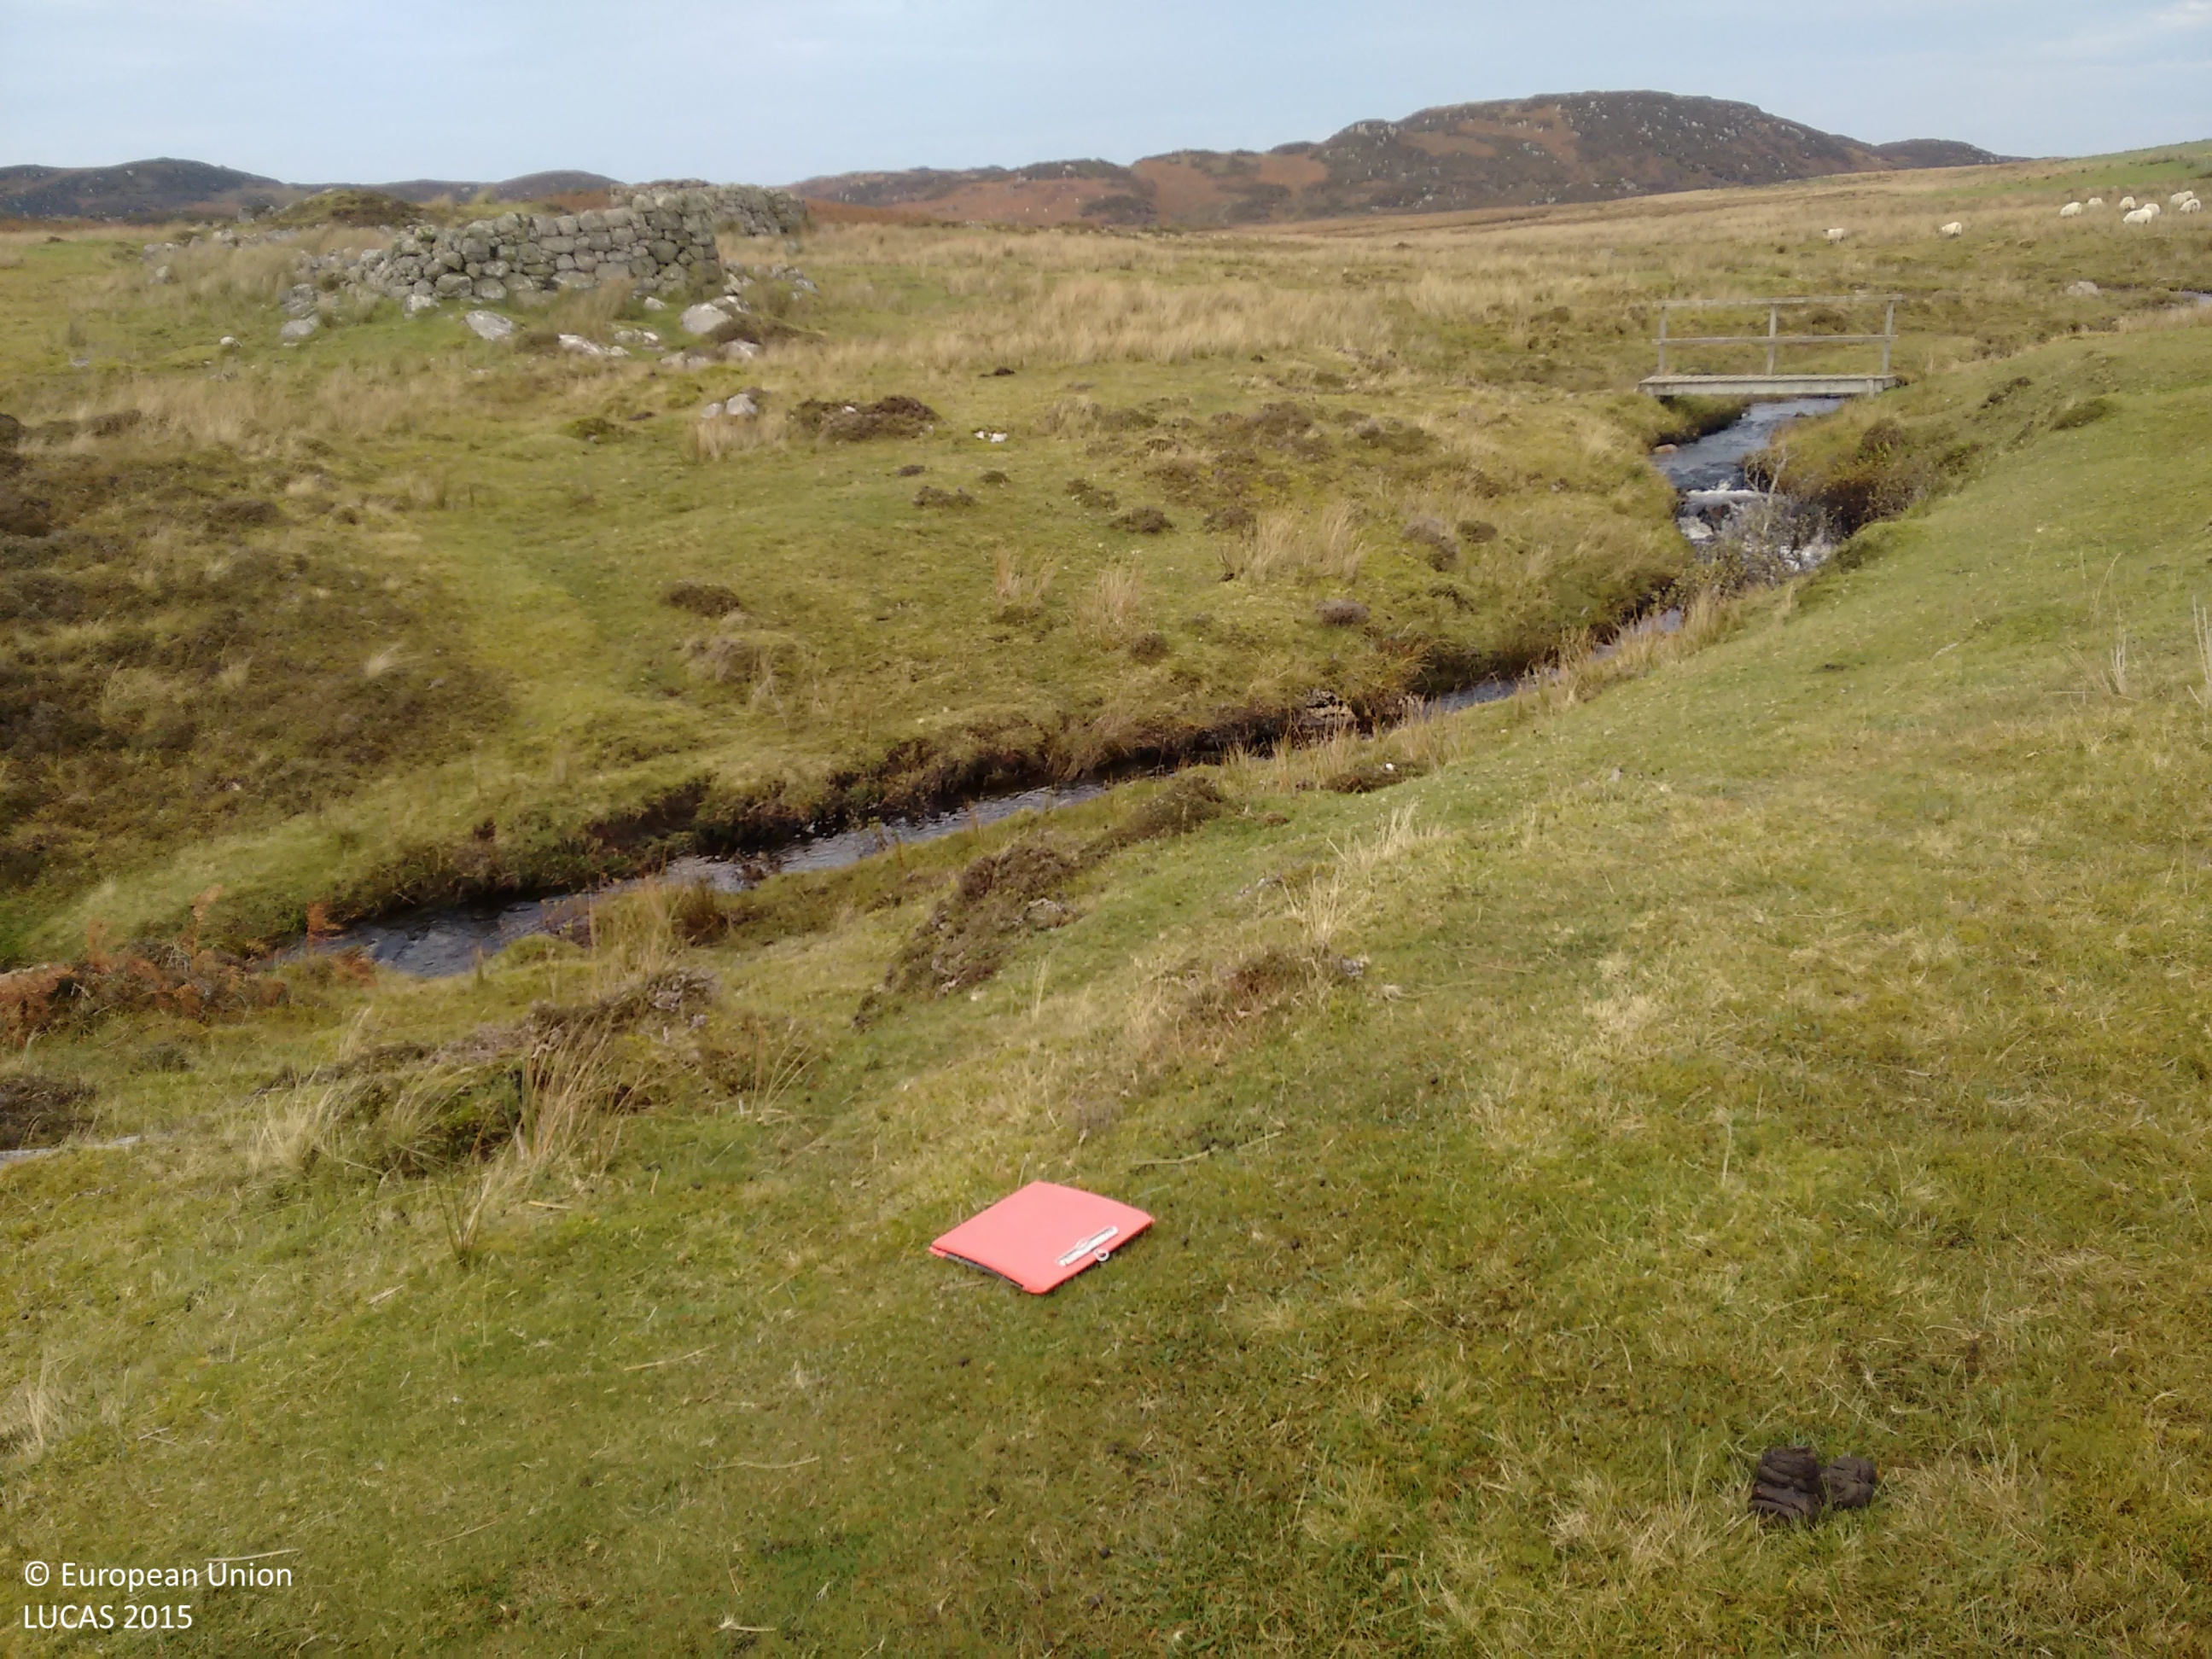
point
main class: Grassland
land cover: Grassland without tree/shrub cover
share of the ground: > 75 %
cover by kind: herbaceous plants 90 %, lichens and mosses 10 %
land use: Agriculture (excluding fallow land and kitchen gardens)
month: October
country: GB
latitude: 56.2996
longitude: -6.2533
